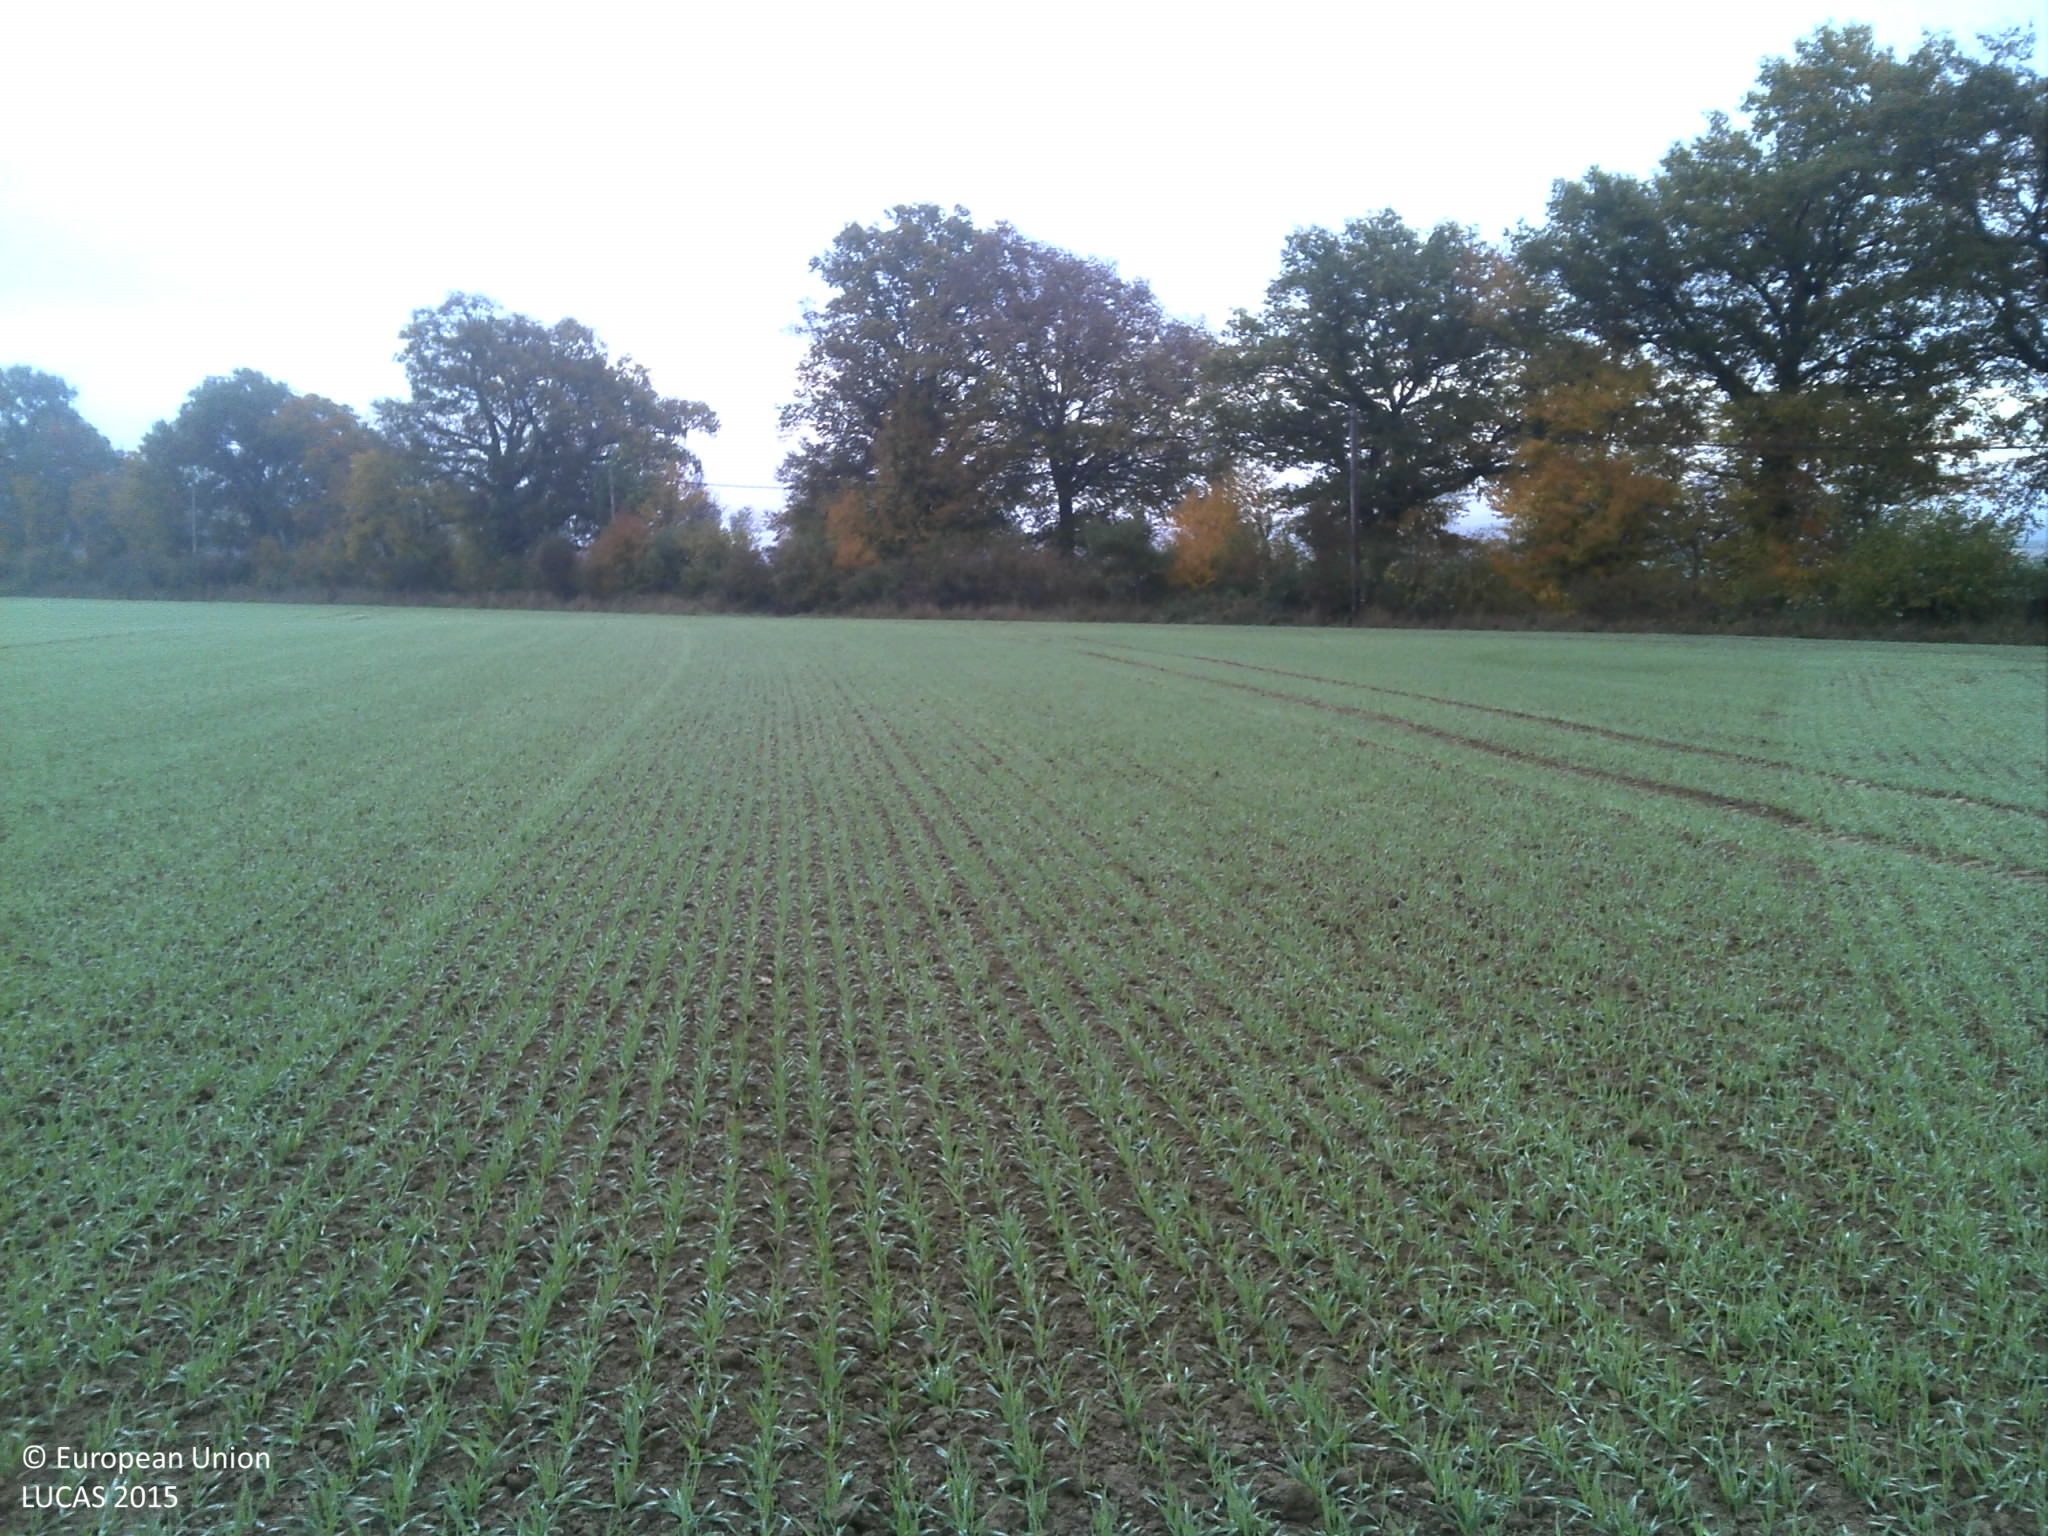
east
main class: Cropland
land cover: Common wheat
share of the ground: > 75 %
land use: Agriculture (excluding fallow land and kitchen gardens)
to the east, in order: Common wheat; Grass margins; Electric lines; Broadleaved woodland; Ditches and canals; Broadleaved woodland; Grassland without tree/shrub cover; Other bare soil; Grass margins; Tracks; Grass margins
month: October
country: FR
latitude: 47.1222
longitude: 5.0844
